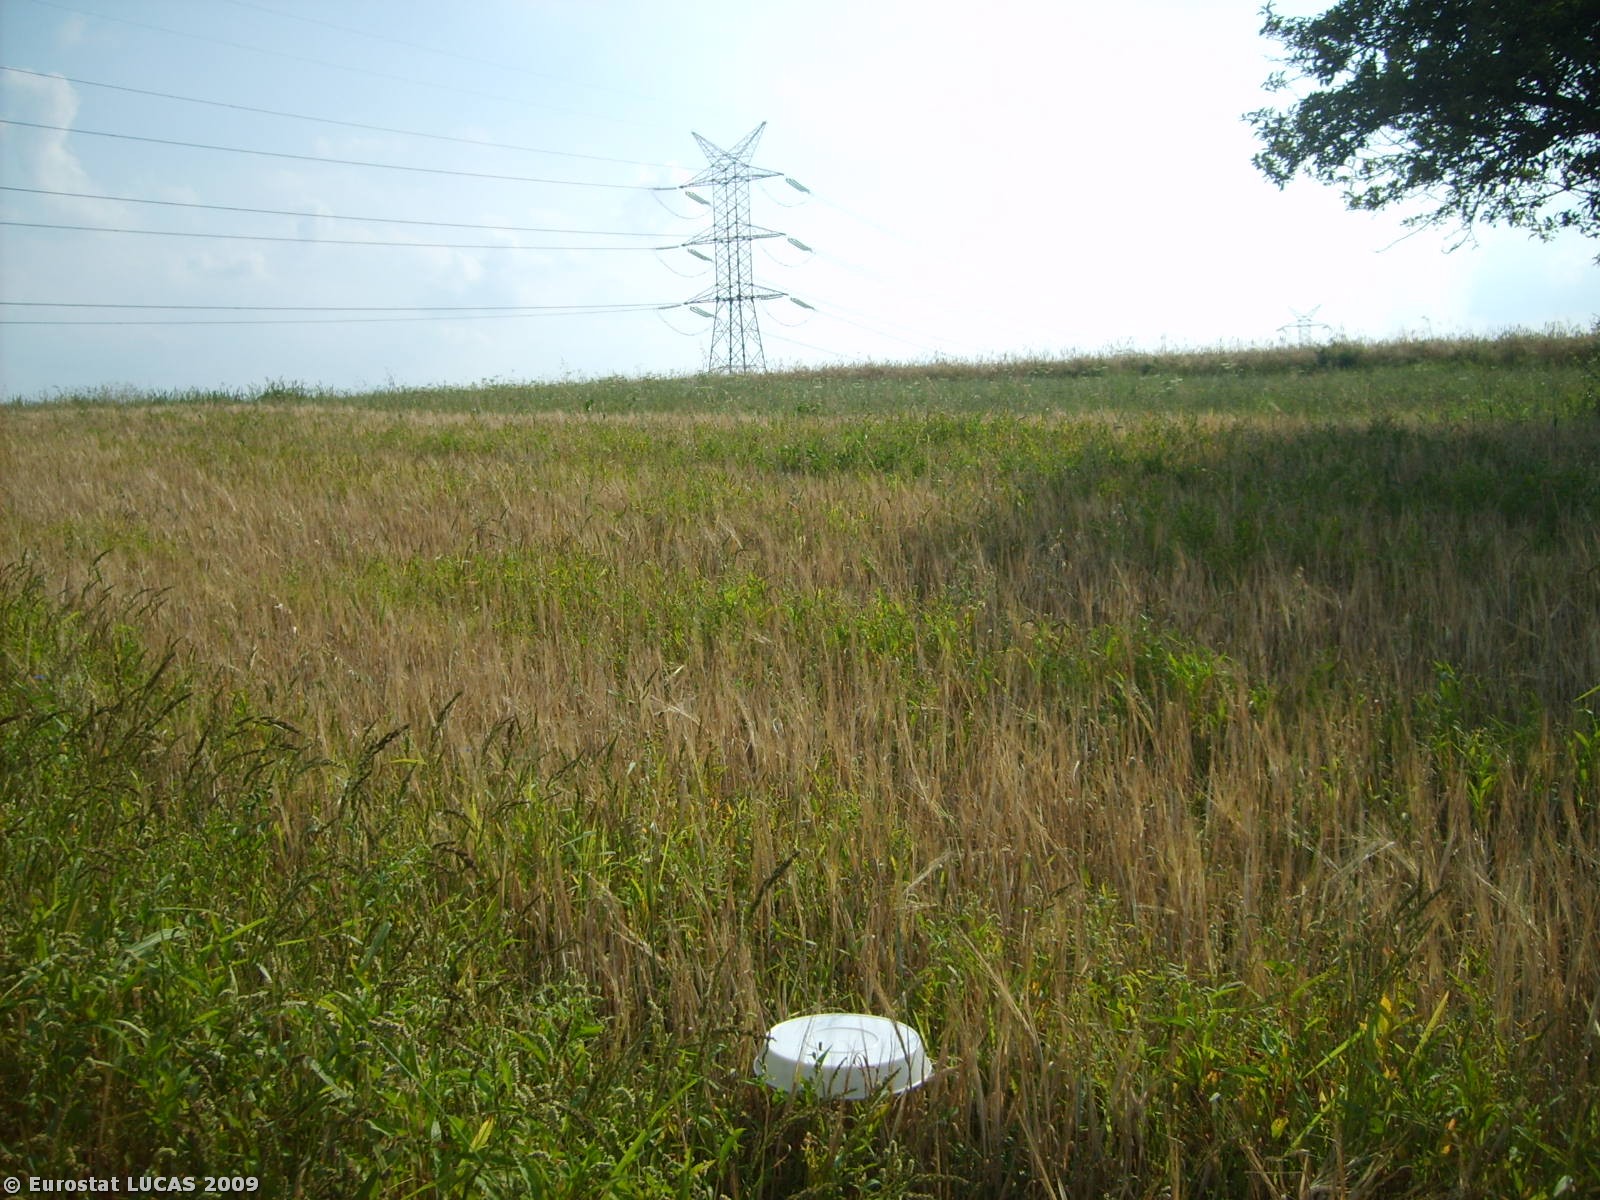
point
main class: Cropland
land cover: Barley
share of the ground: 25 - 50 %
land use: Agriculture (excluding fallow land and kitchen gardens)
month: July
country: PL
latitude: 49.9260
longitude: 20.1888
